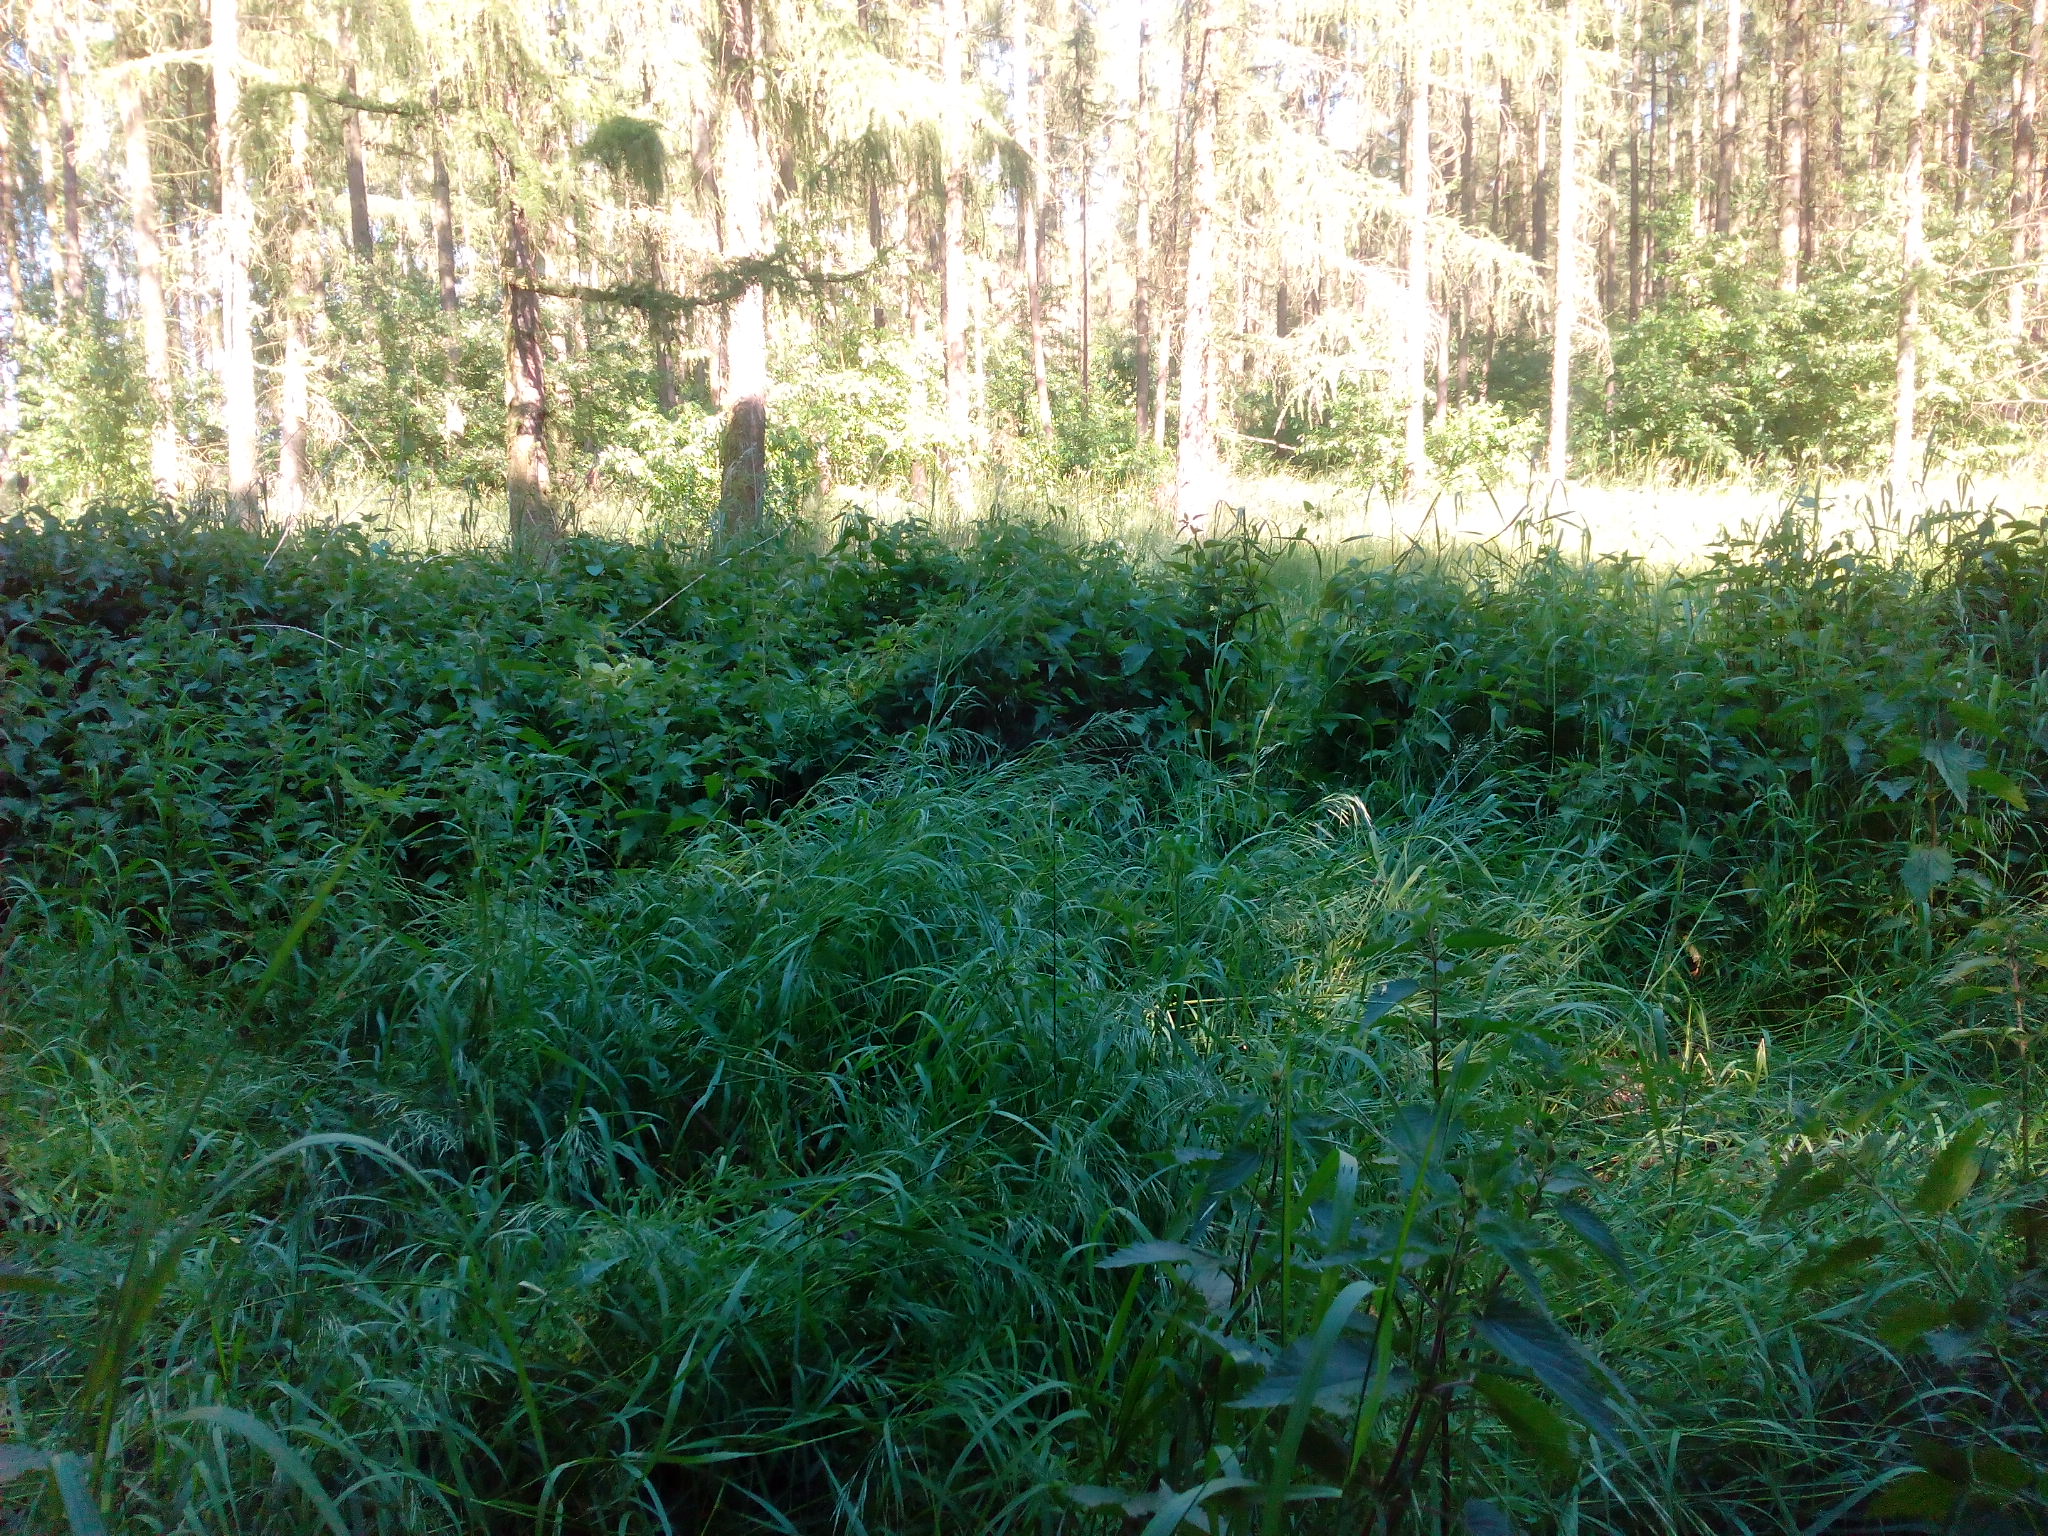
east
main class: Woodland
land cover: Broadleaved woodland
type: mesophytic deciduous forest
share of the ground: 25 - 50 %
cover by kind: broadleaved forest trees 40 %, herbaceous plants 30 %, shrubs 20 %, coniferous forest trees 10 %
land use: Forestry
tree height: > 5 m
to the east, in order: Broadleaved woodland; Tracks; Other coniferous woodland; Artificial constructions in urban areas
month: June
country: DE
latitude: 53.1322
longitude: 14.1708
